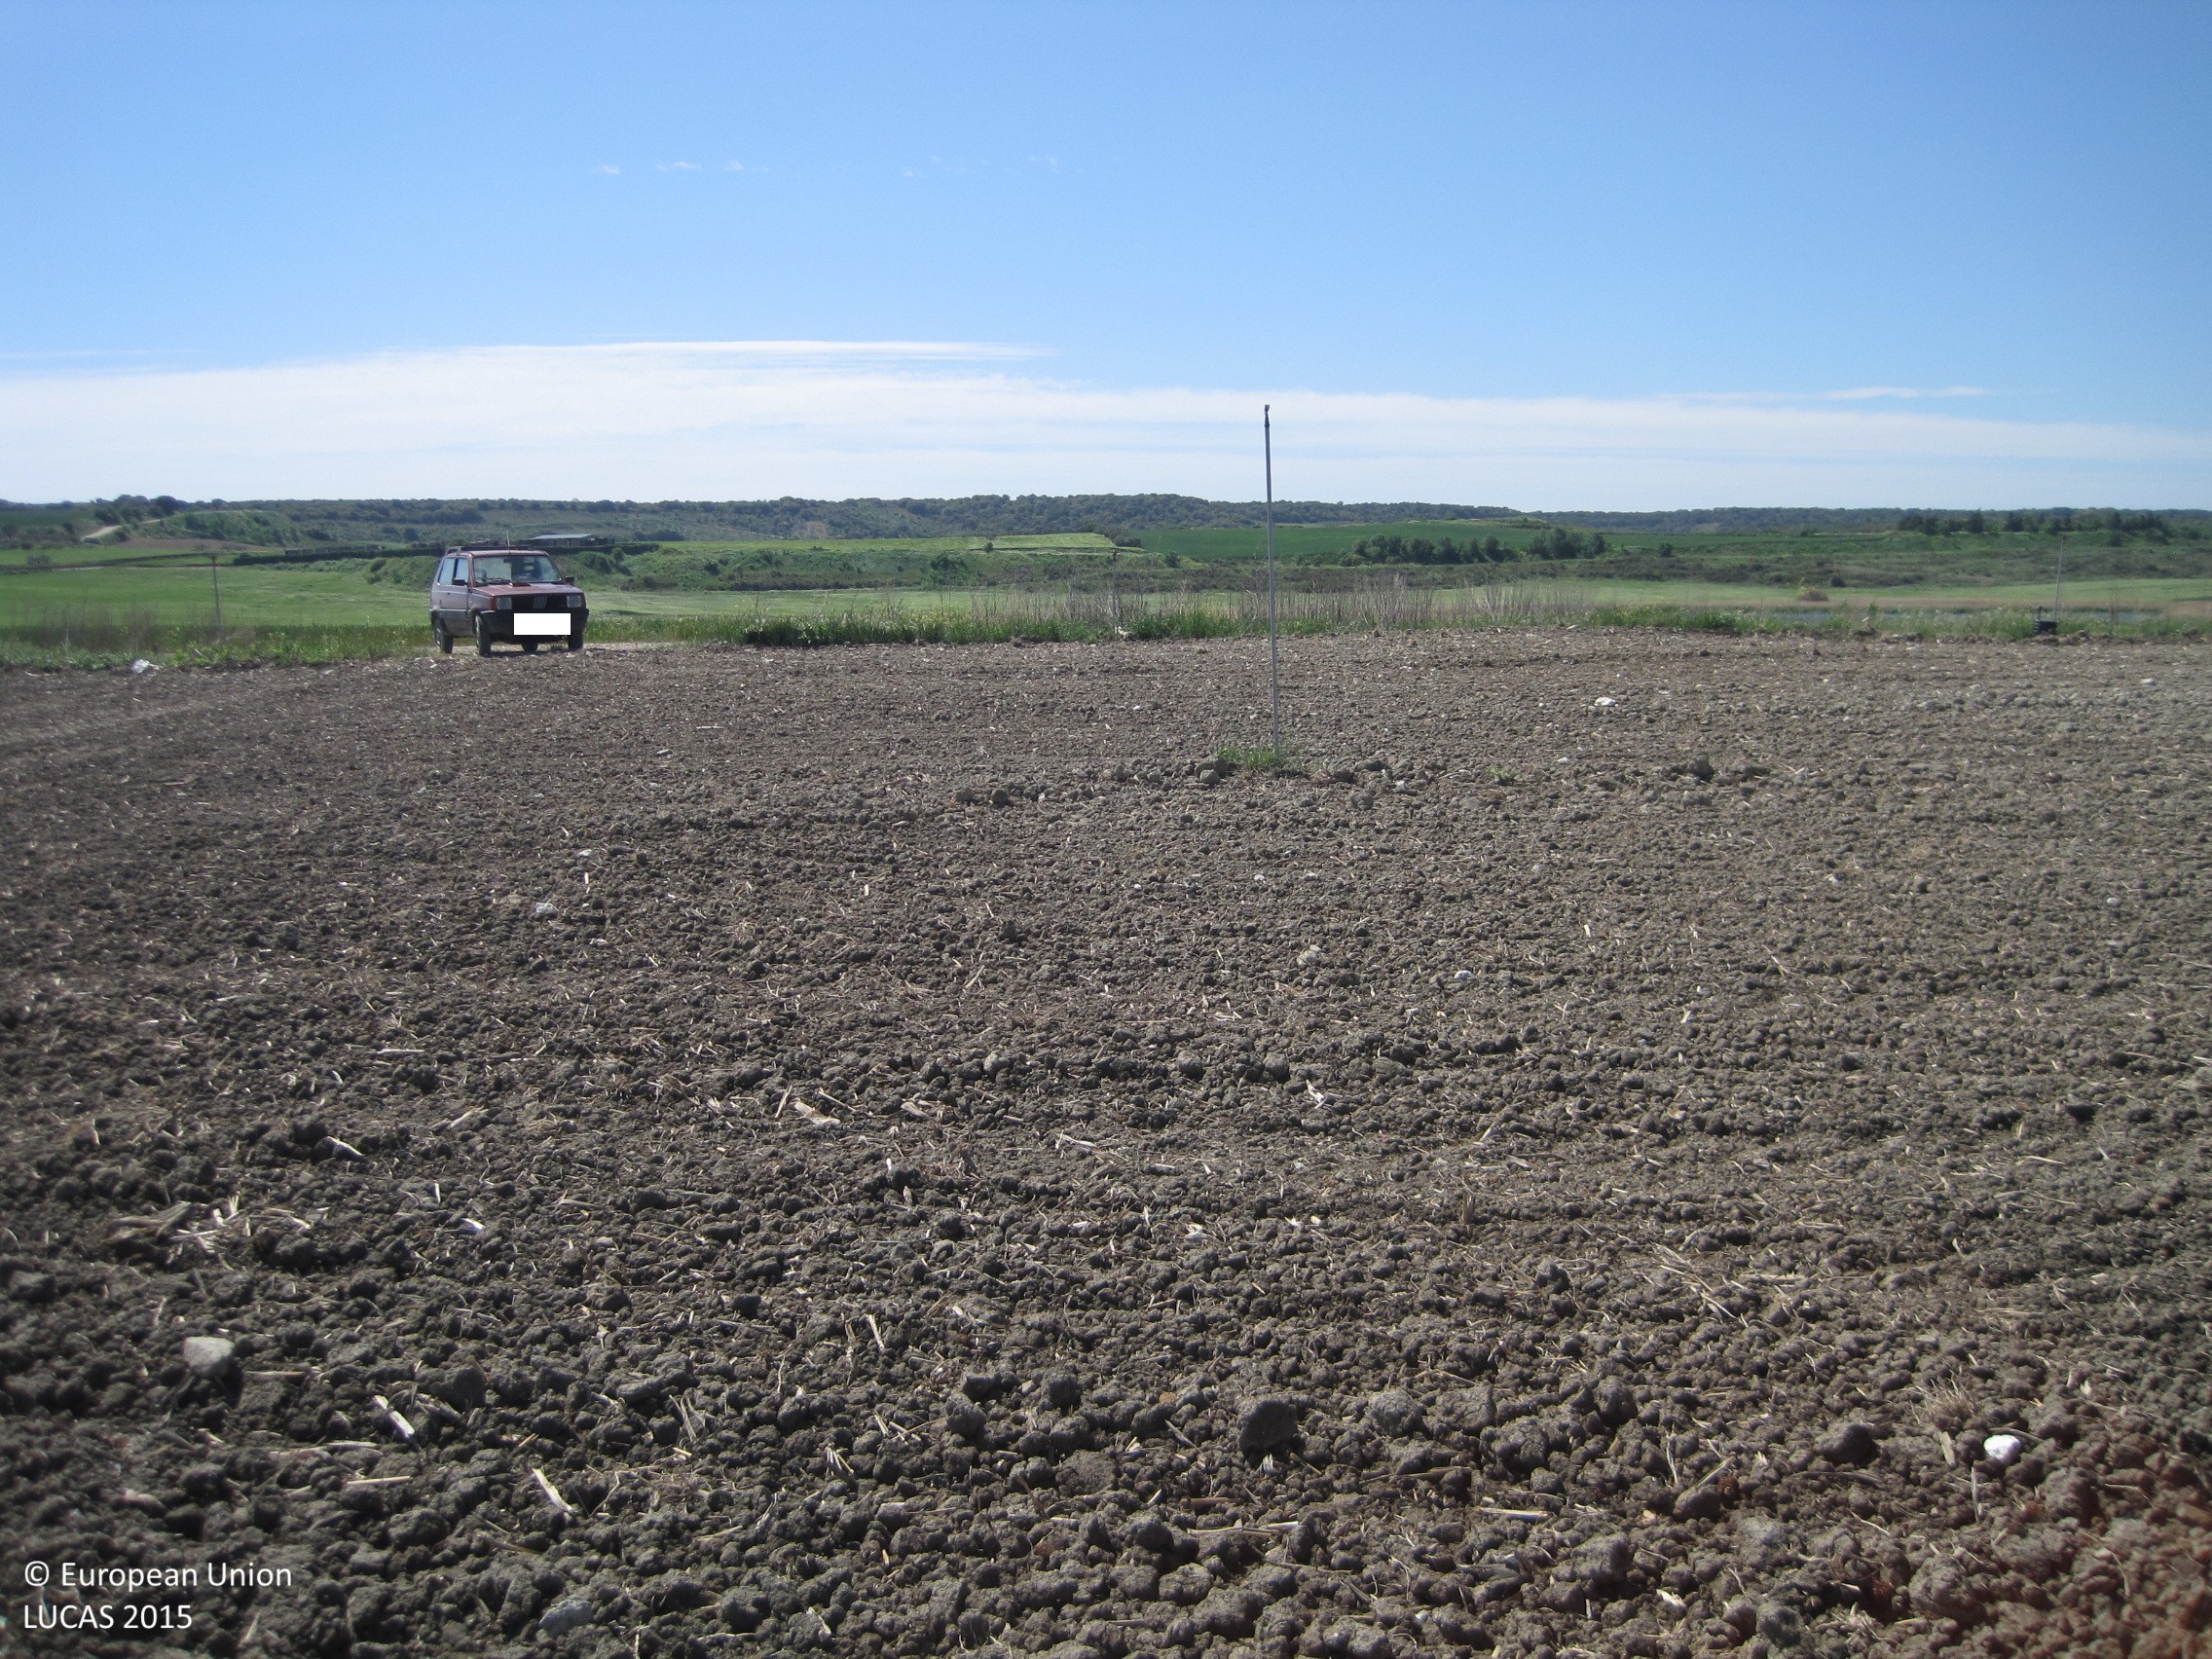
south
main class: Cropland
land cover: Maize
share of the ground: < 10 %
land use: Agriculture (excluding fallow land and kitchen gardens)
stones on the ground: < 10 %
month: May
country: ES
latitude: 42.5191
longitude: -1.7103
